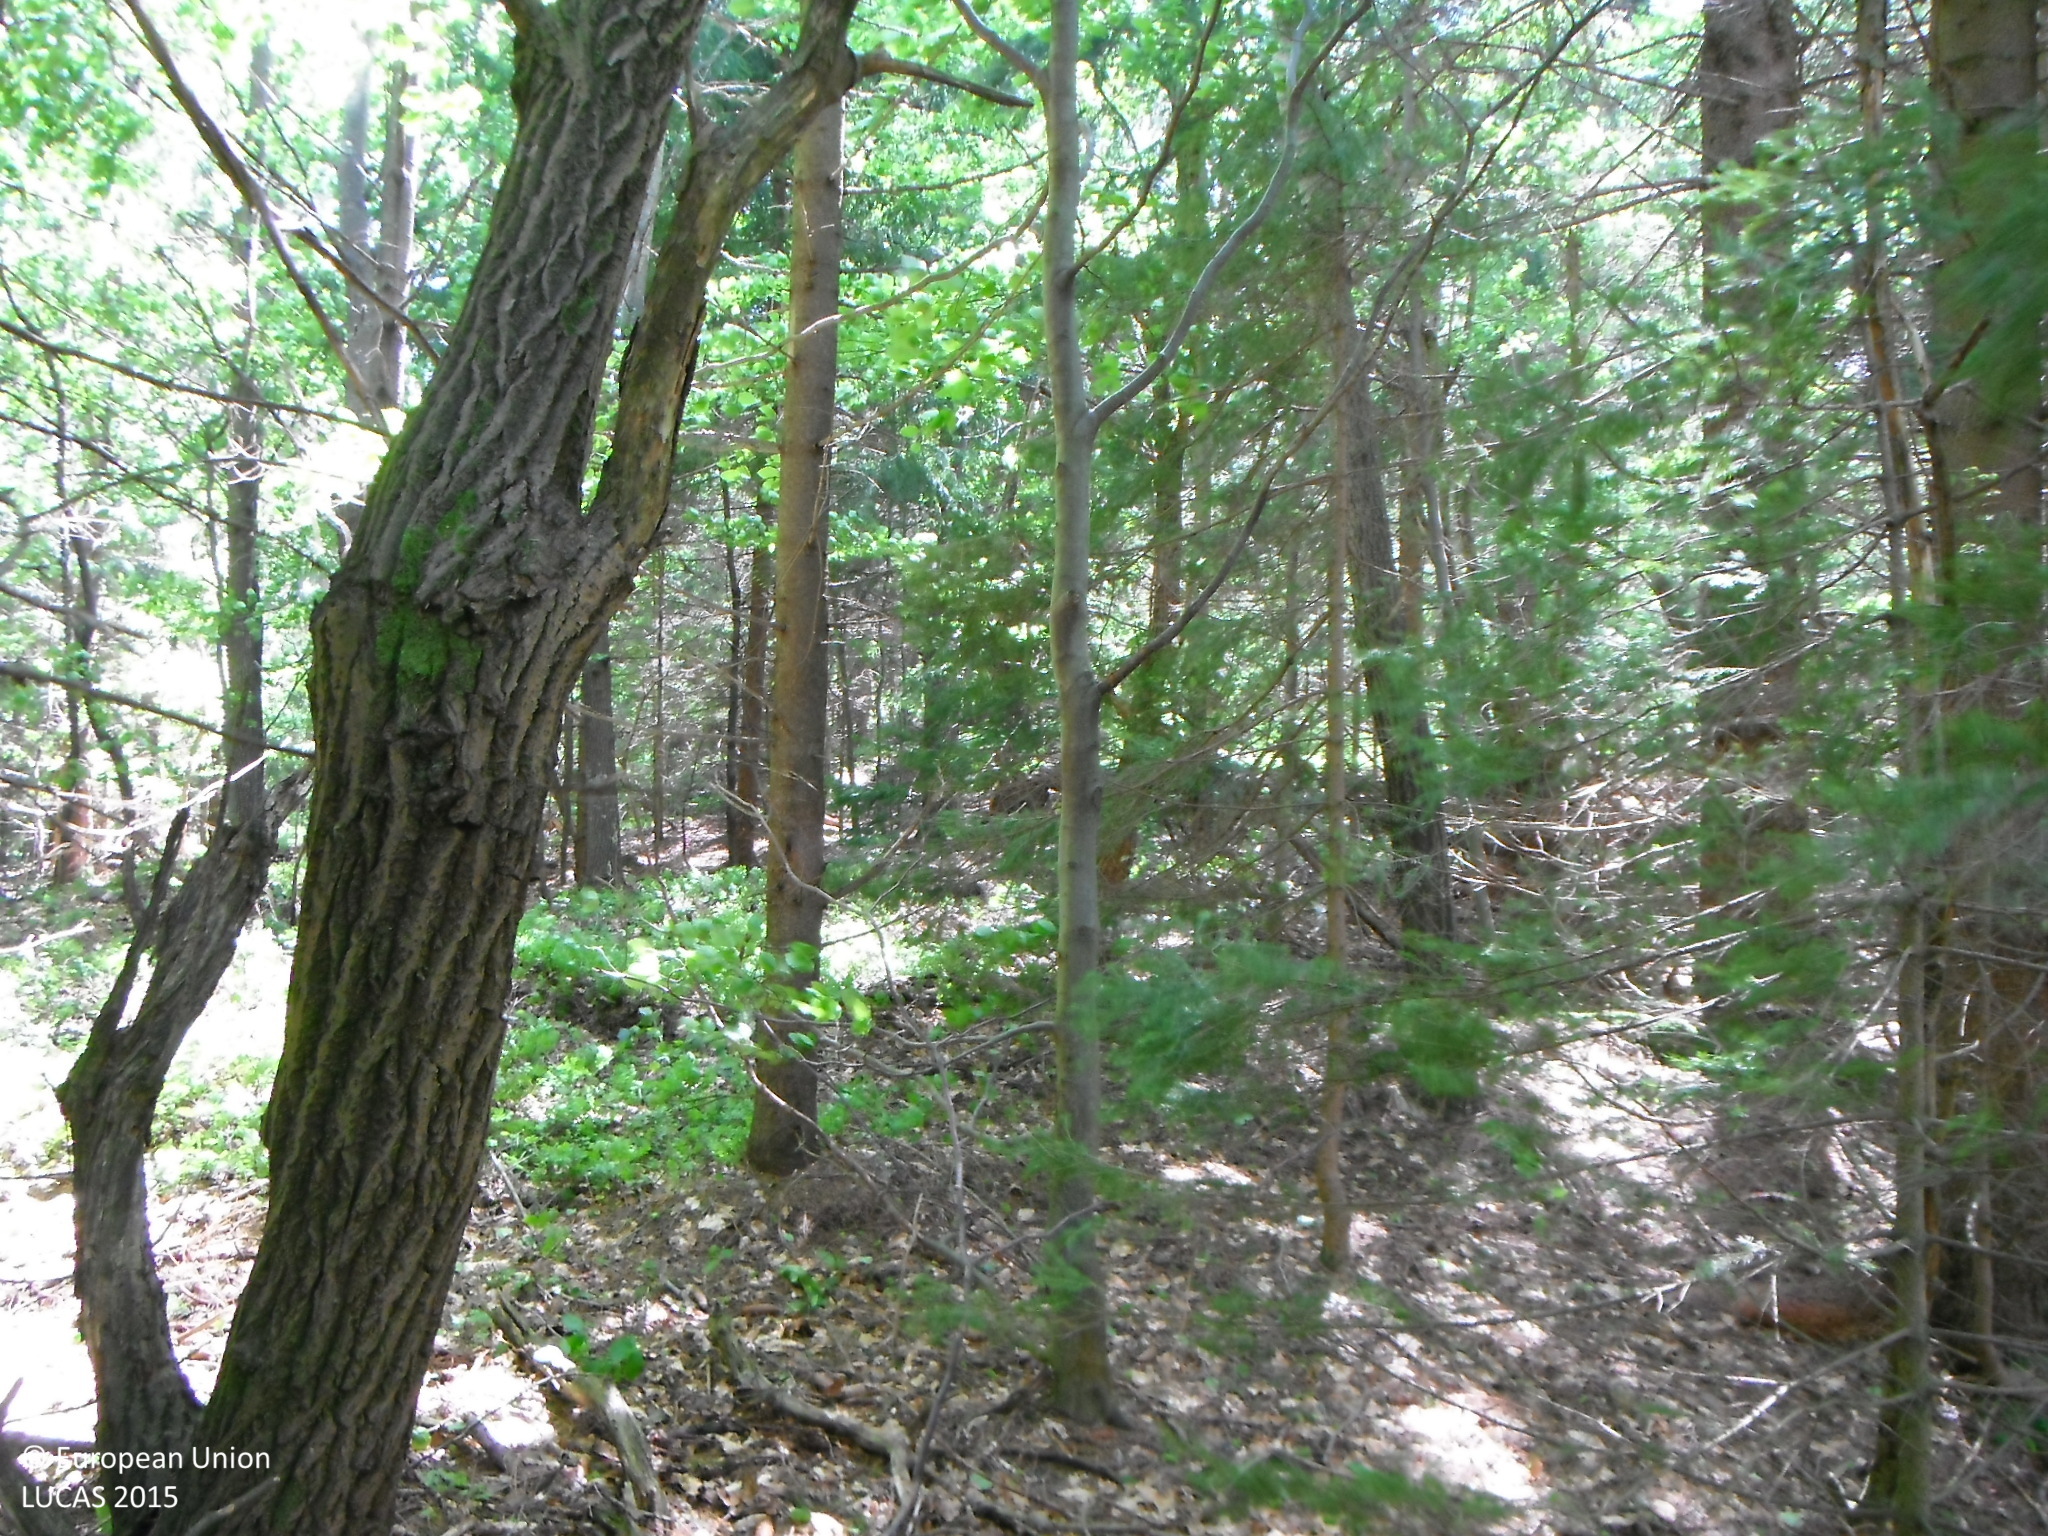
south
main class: Woodland
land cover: Spruce dominated mixed woodland
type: hemiboreal forest and nemoral coniferous forest and mixed broadleaved-coniferous forest
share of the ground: > 75 %
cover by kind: coniferous forest trees 70 %, broadleaved forest trees 30 %
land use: Forestry
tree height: > 5 m
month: May
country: SK
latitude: 48.8325
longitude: 19.2187
